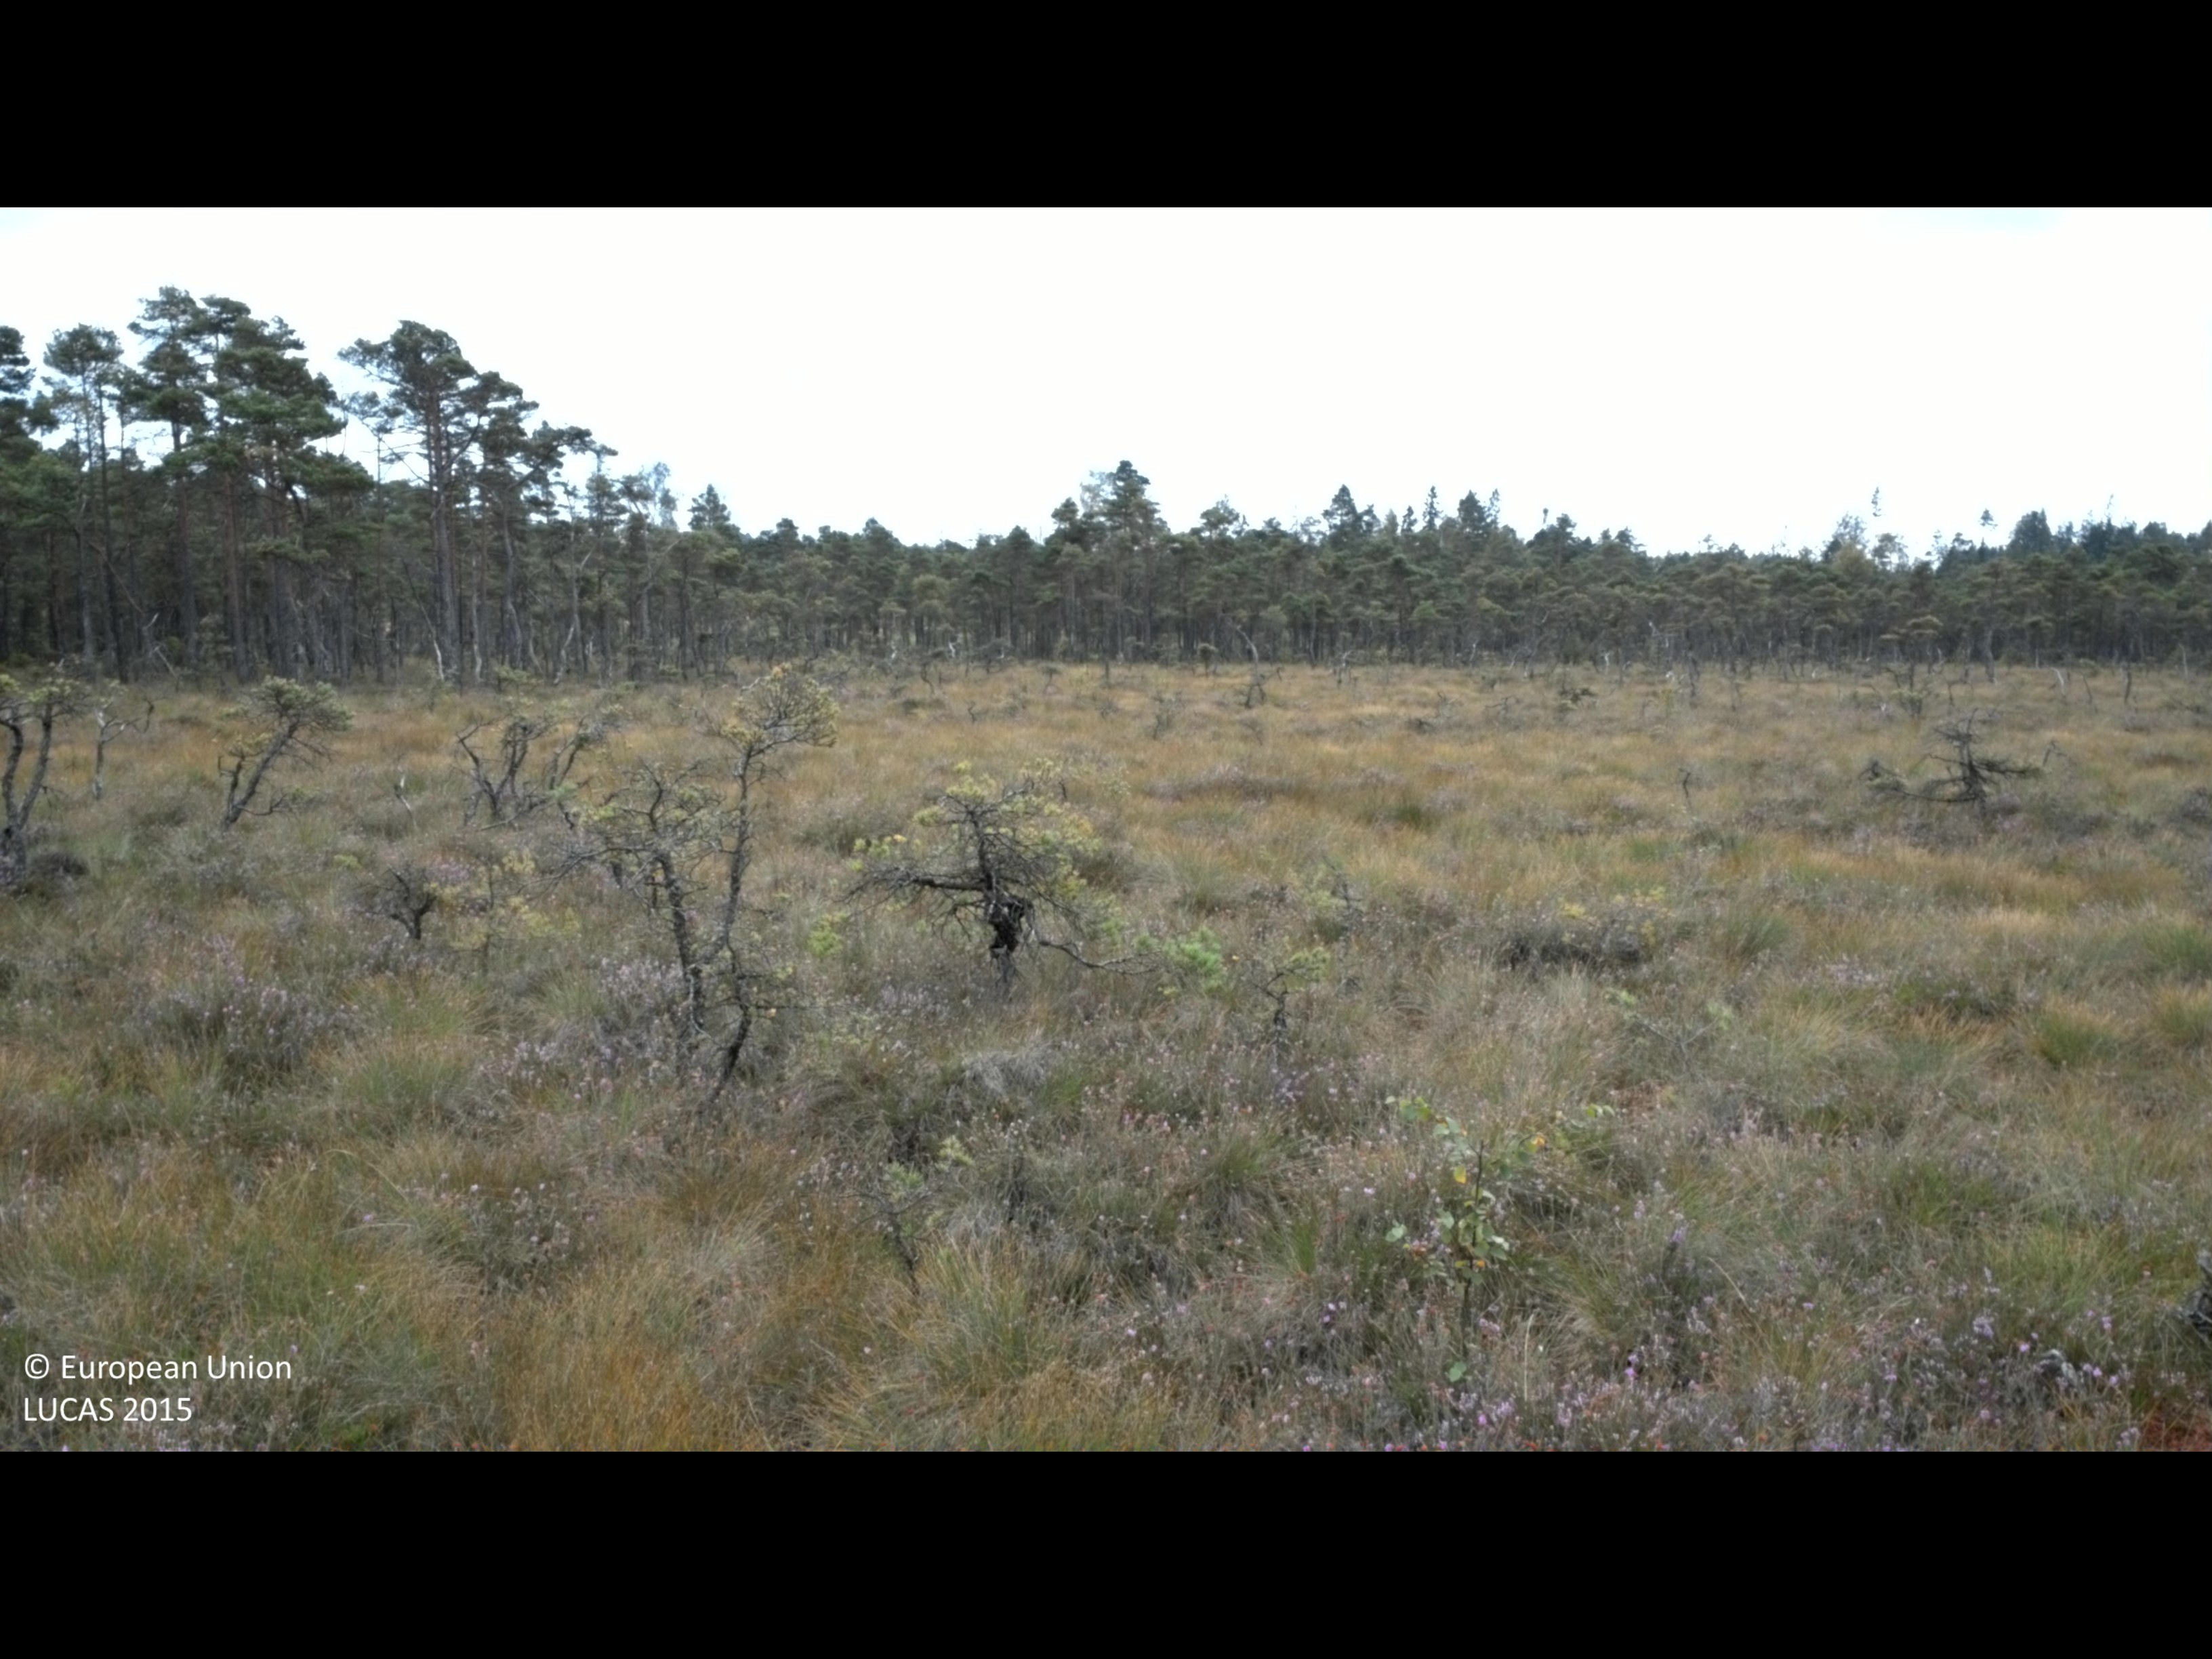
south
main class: Woodland
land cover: Pine dominated coniferous woodland
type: mire and swamp forests
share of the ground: 25 - 50 %
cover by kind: coniferous forest trees 40 %, shrubs 30 %, herbaceous plants 30 %
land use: Semi-natural and natural areas not in use
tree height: < 5 m
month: August
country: SE
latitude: 56.8677
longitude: 13.1954
